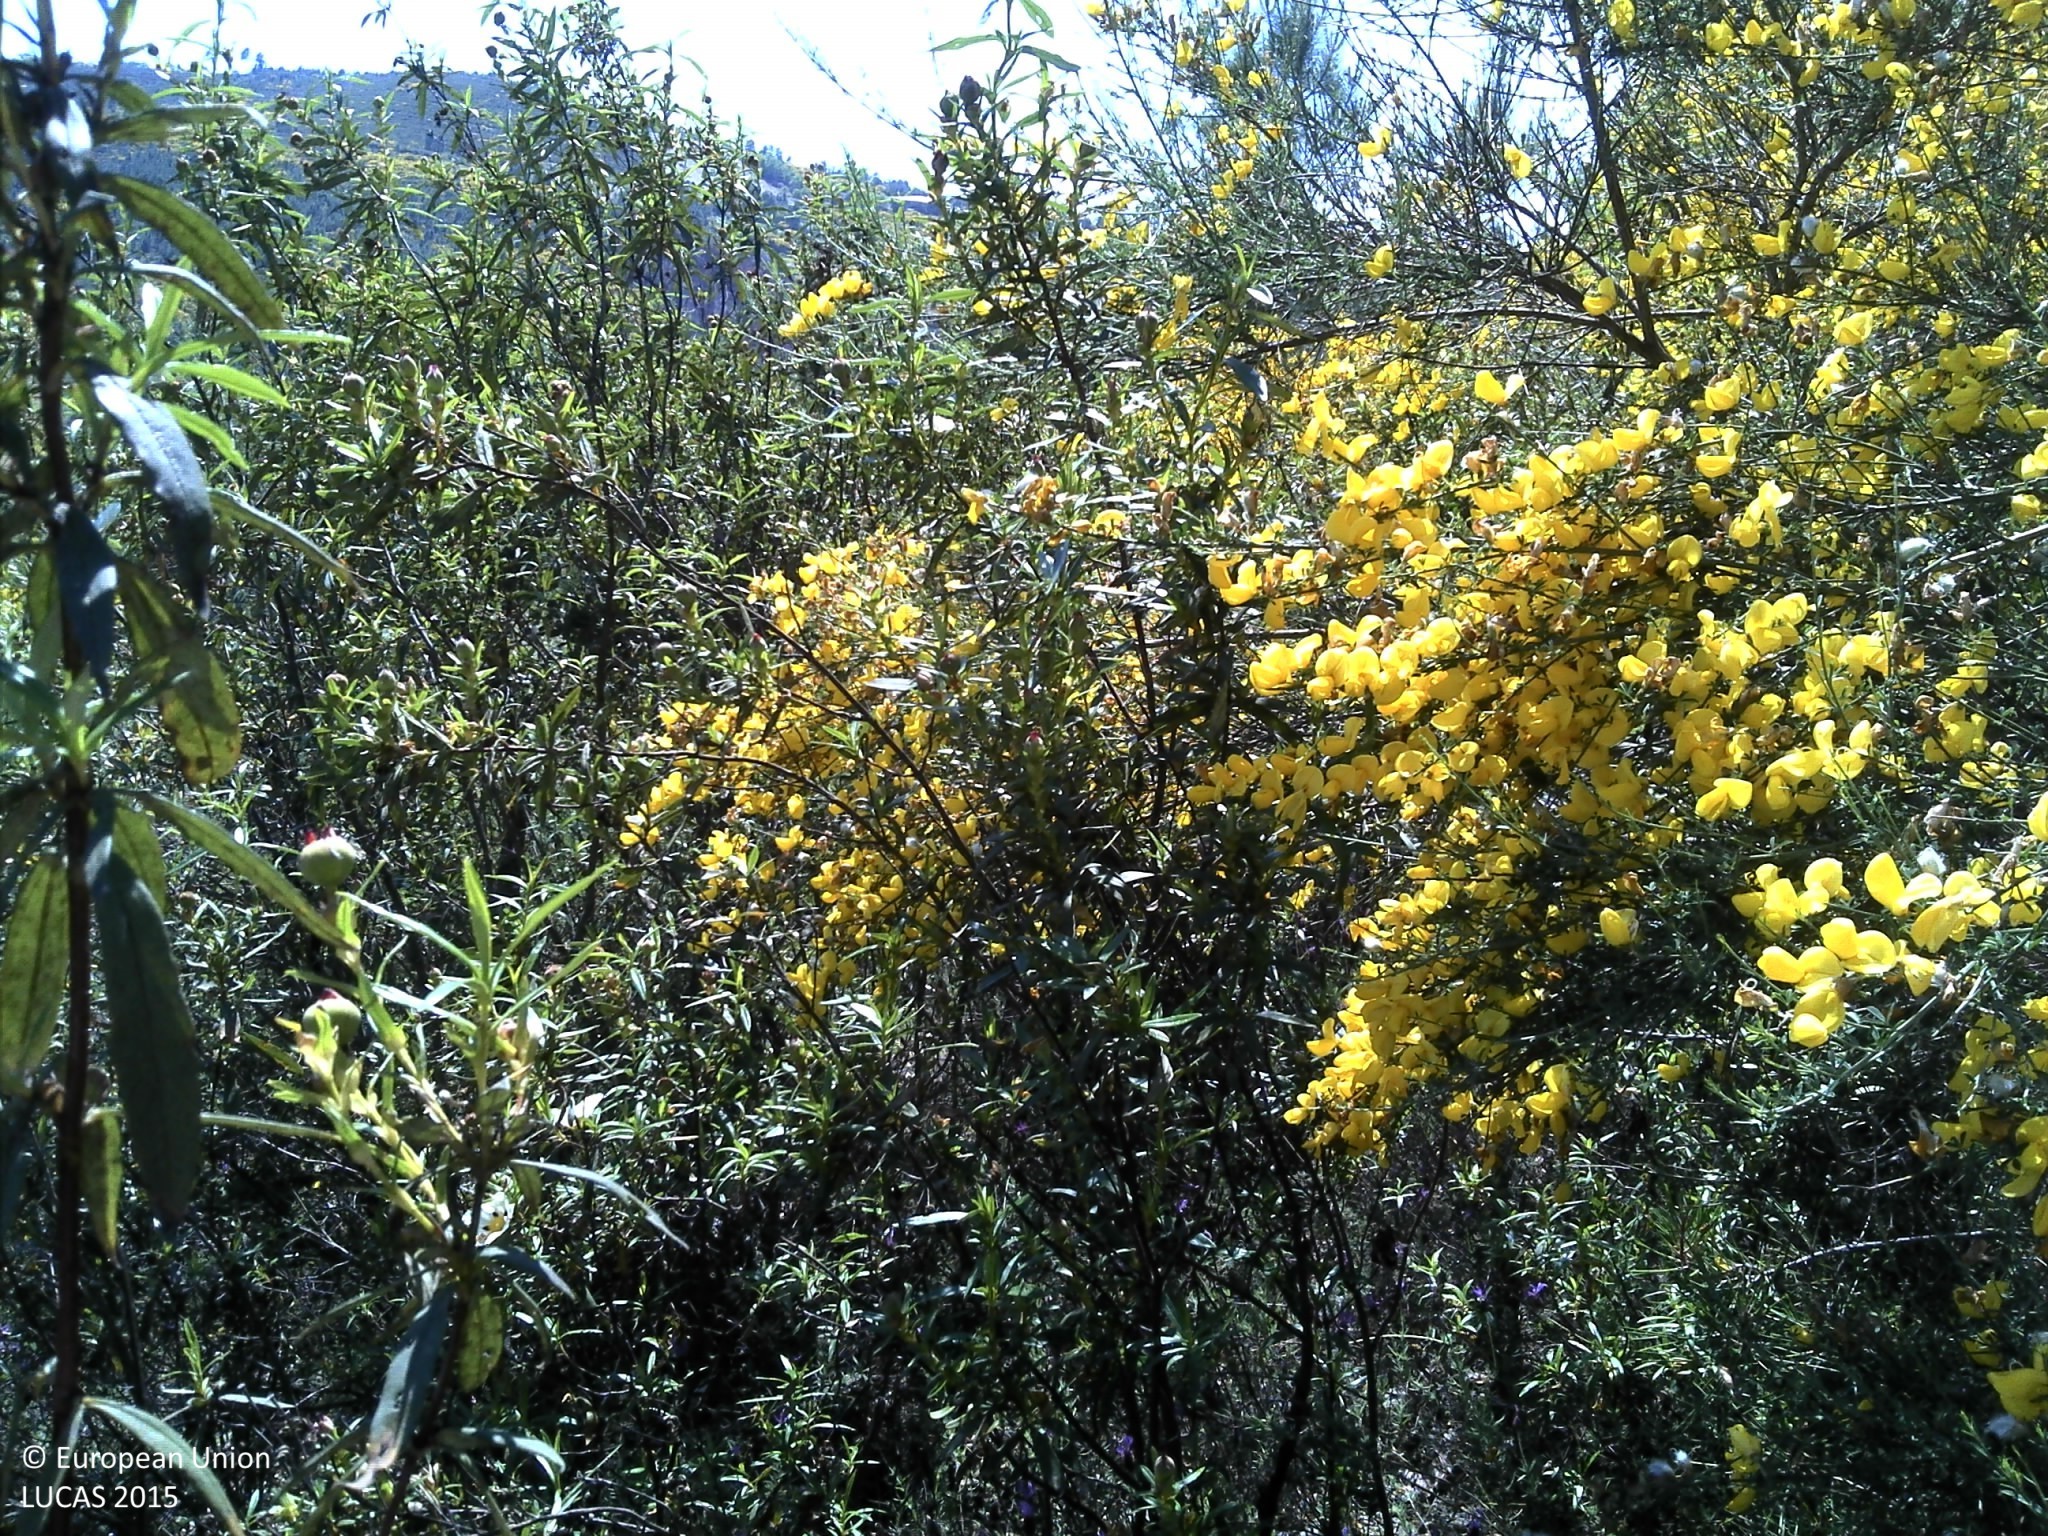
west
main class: Shrubland
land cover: Shrubland with sparse tree cover
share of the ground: > 75 %
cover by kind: shrubs 90 %, coniferous forest trees 5 %, unconsolidated bare surface 5 %
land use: Forestry
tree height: > 5 m
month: May
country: PT
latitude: 41.7380
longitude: -7.1102
